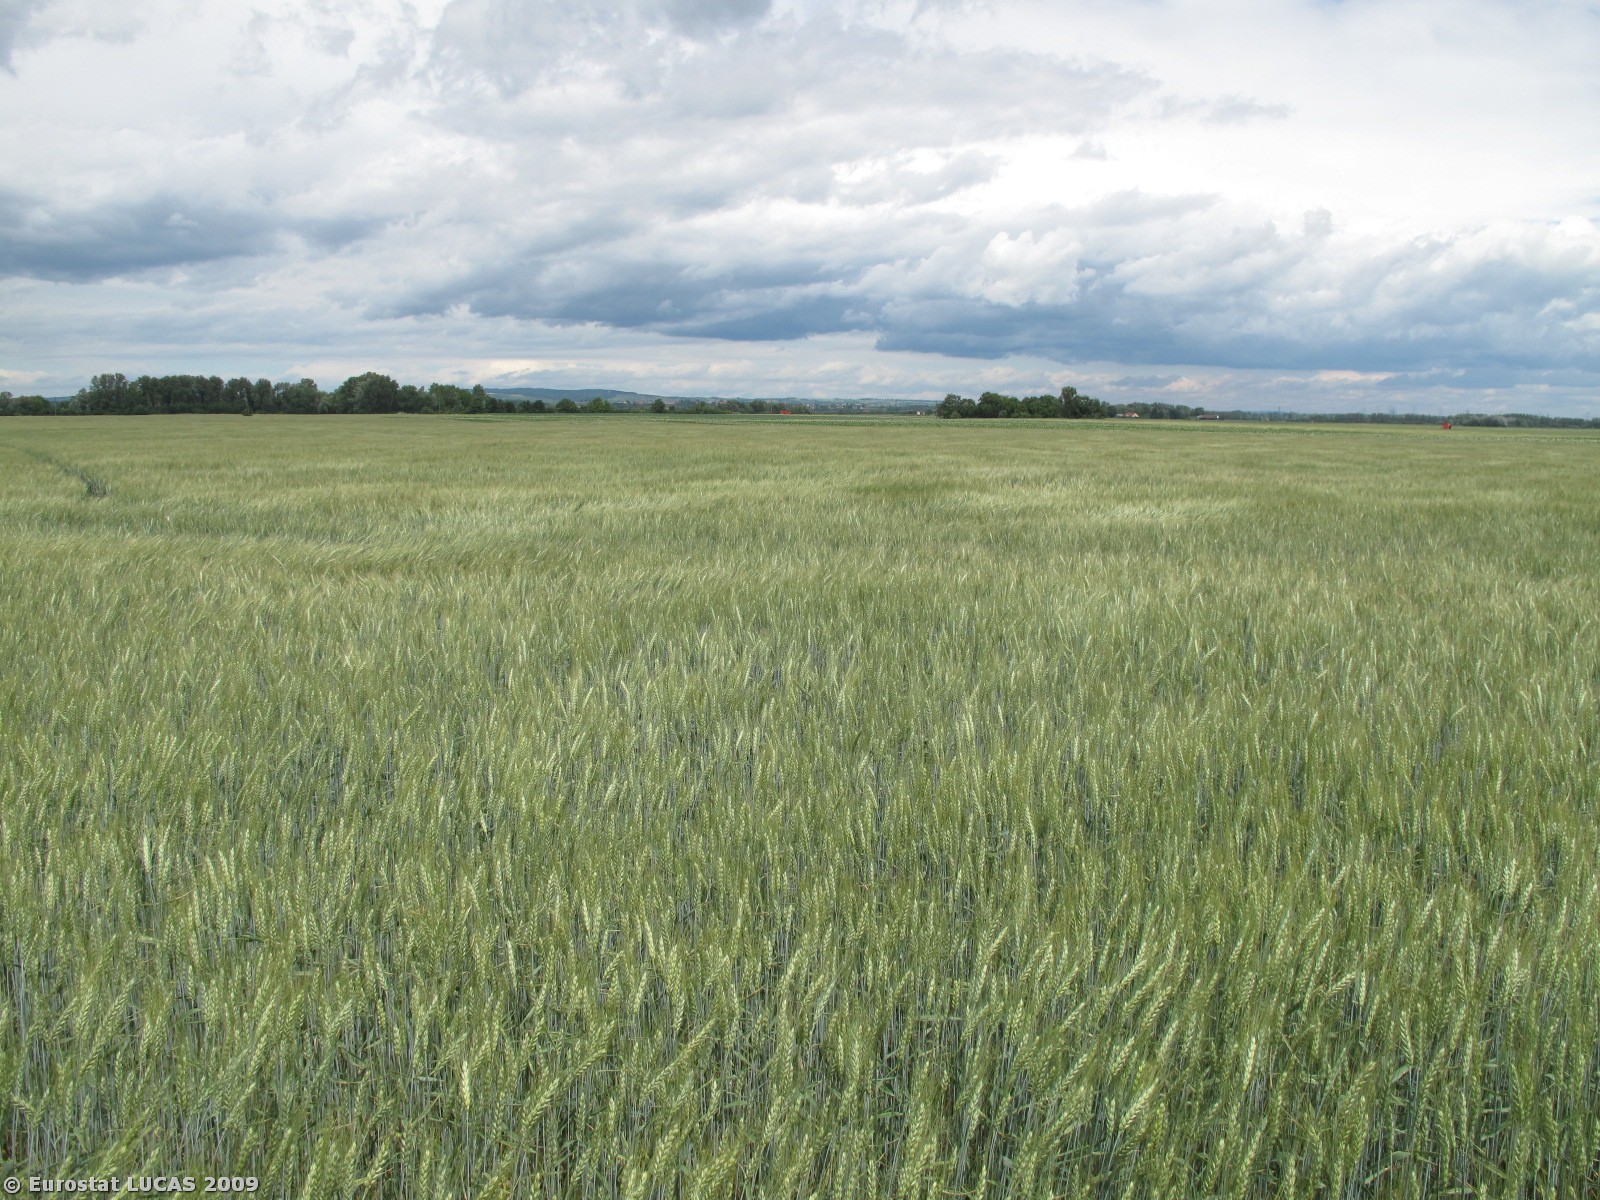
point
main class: Cropland
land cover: Triticale
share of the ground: > 75 %
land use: Agriculture (excluding fallow land and kitchen gardens)
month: June
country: AT
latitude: 48.3663
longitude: 16.0108
